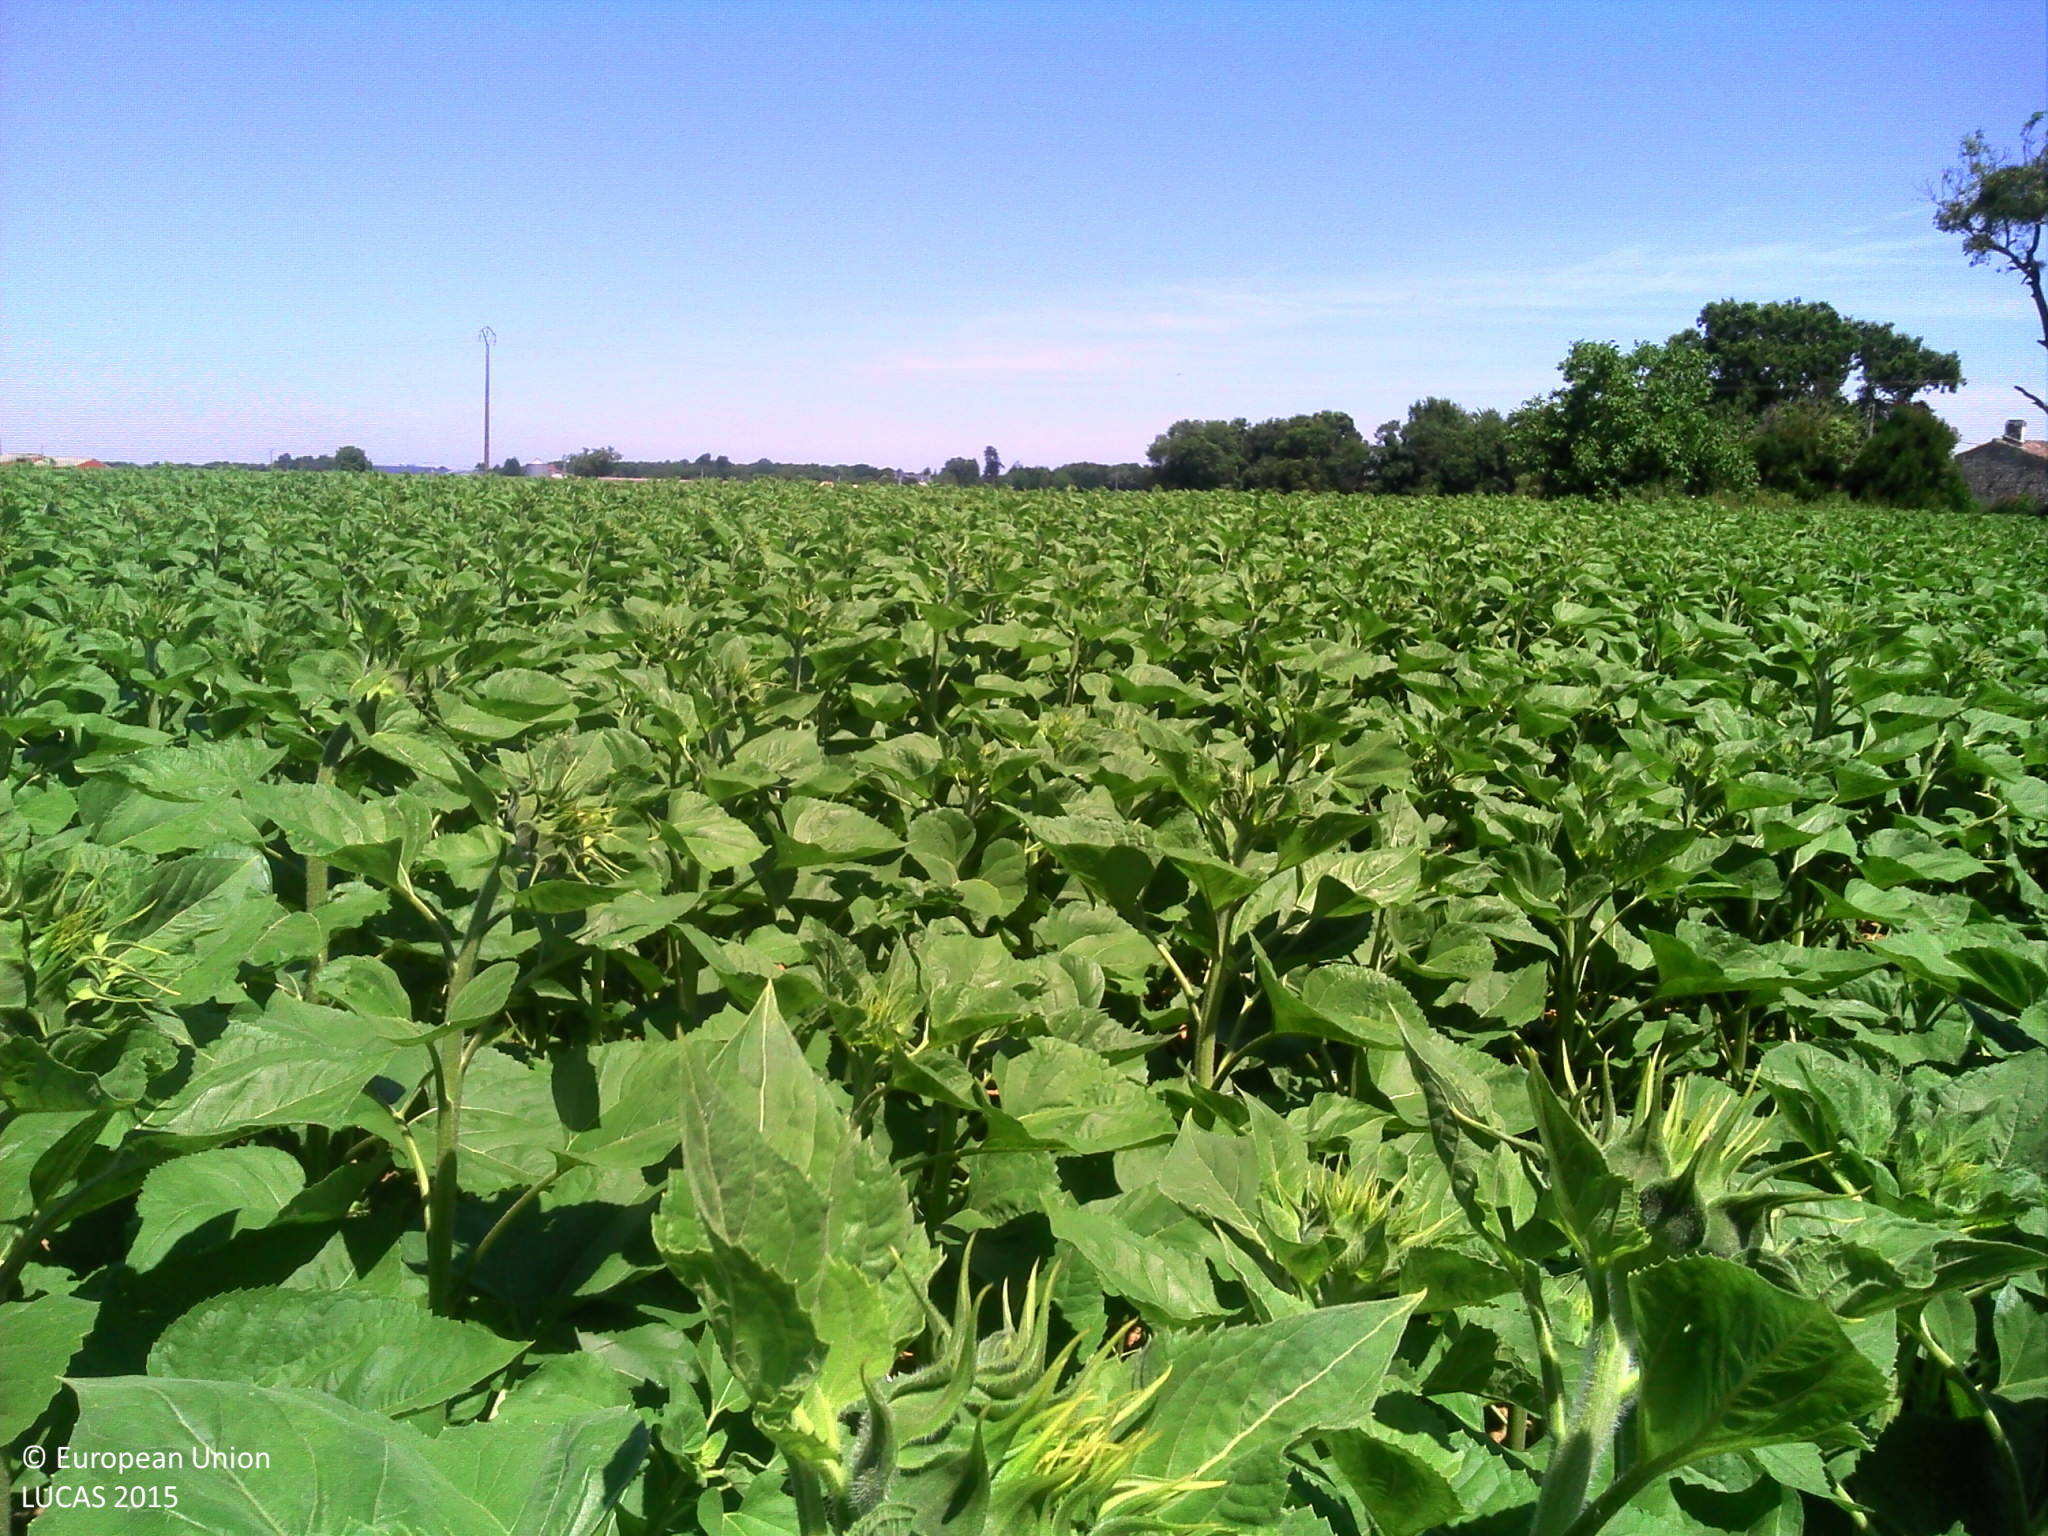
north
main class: Cropland
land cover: Sunflower
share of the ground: > 75 %
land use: Agriculture (excluding fallow land and kitchen gardens)
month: June
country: FR
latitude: 45.6507
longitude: -0.6875
